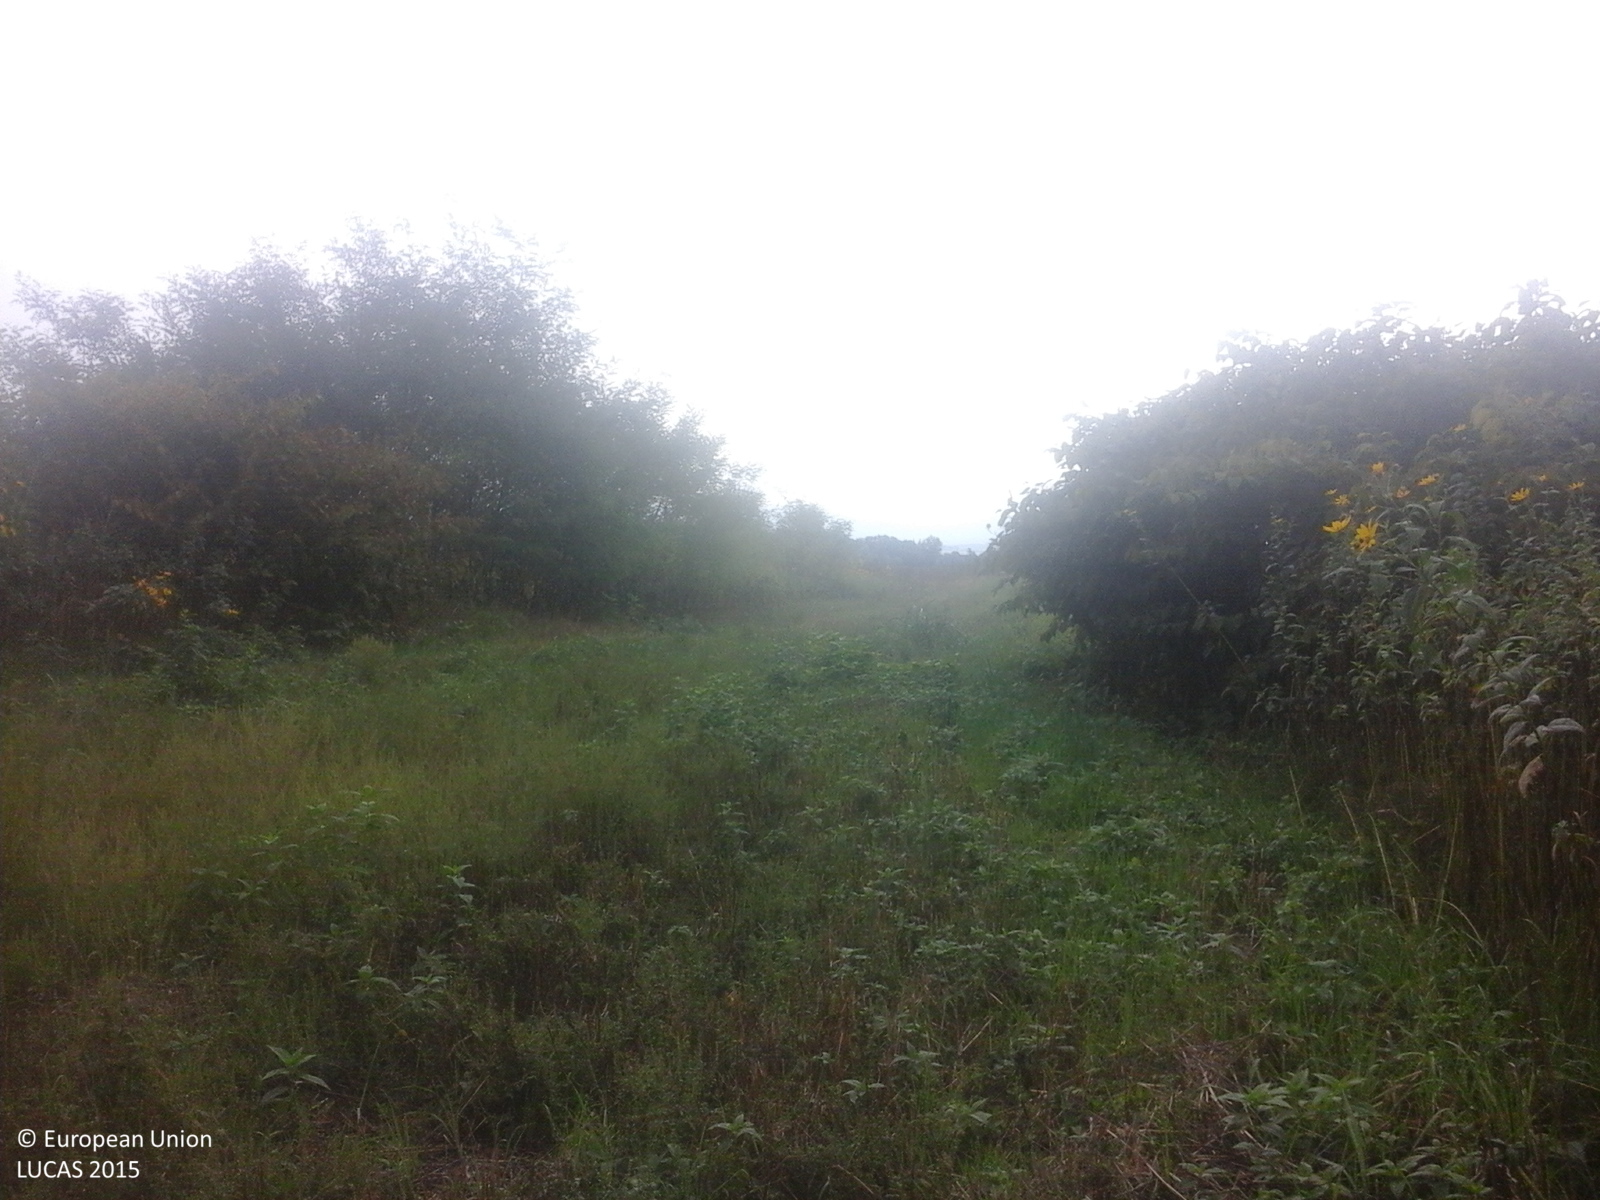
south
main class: Grassland
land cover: Spontaneously vegetated surfaces
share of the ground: > 75 %
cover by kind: herbaceous plants 100 %
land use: Fallow land
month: September
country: RO
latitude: 45.8546
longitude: 22.1617
